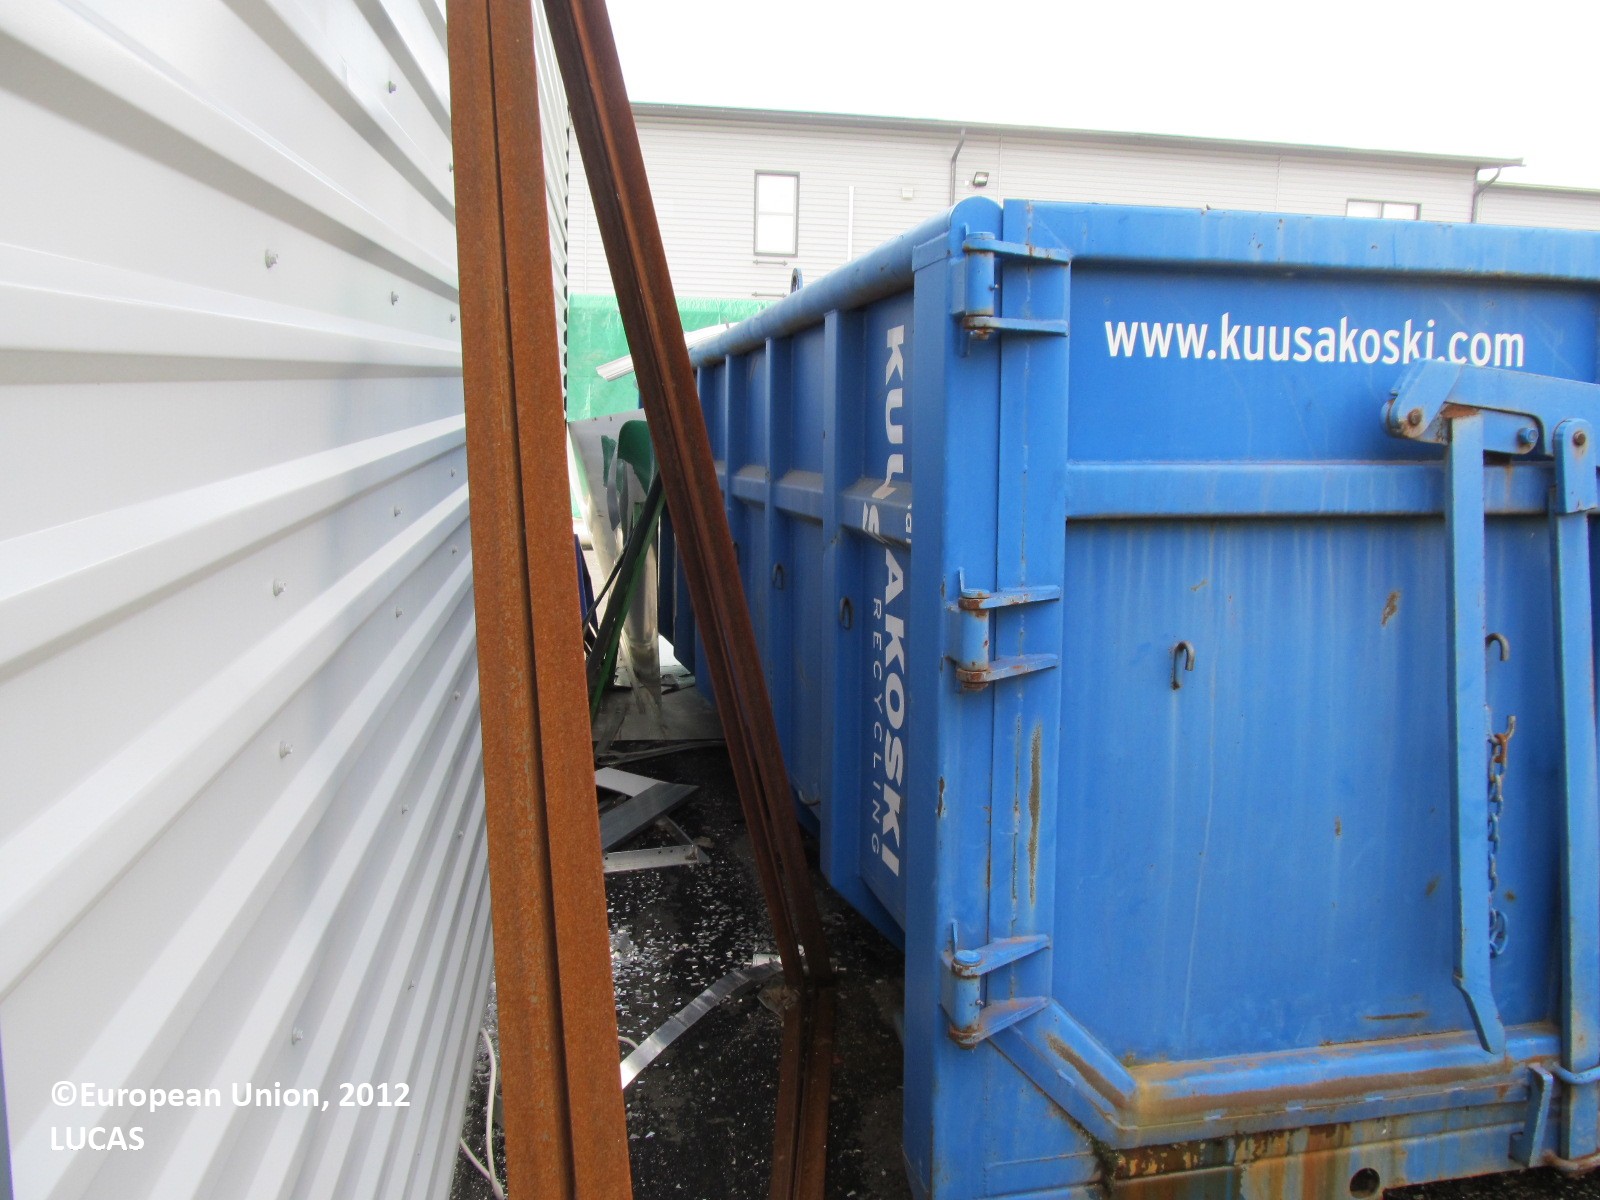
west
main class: Woodland
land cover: Pine dominated mixed woodland
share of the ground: 25 - 50 %
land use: Commerce, finance, business
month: August
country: FI
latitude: 62.9623
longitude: 27.6980
